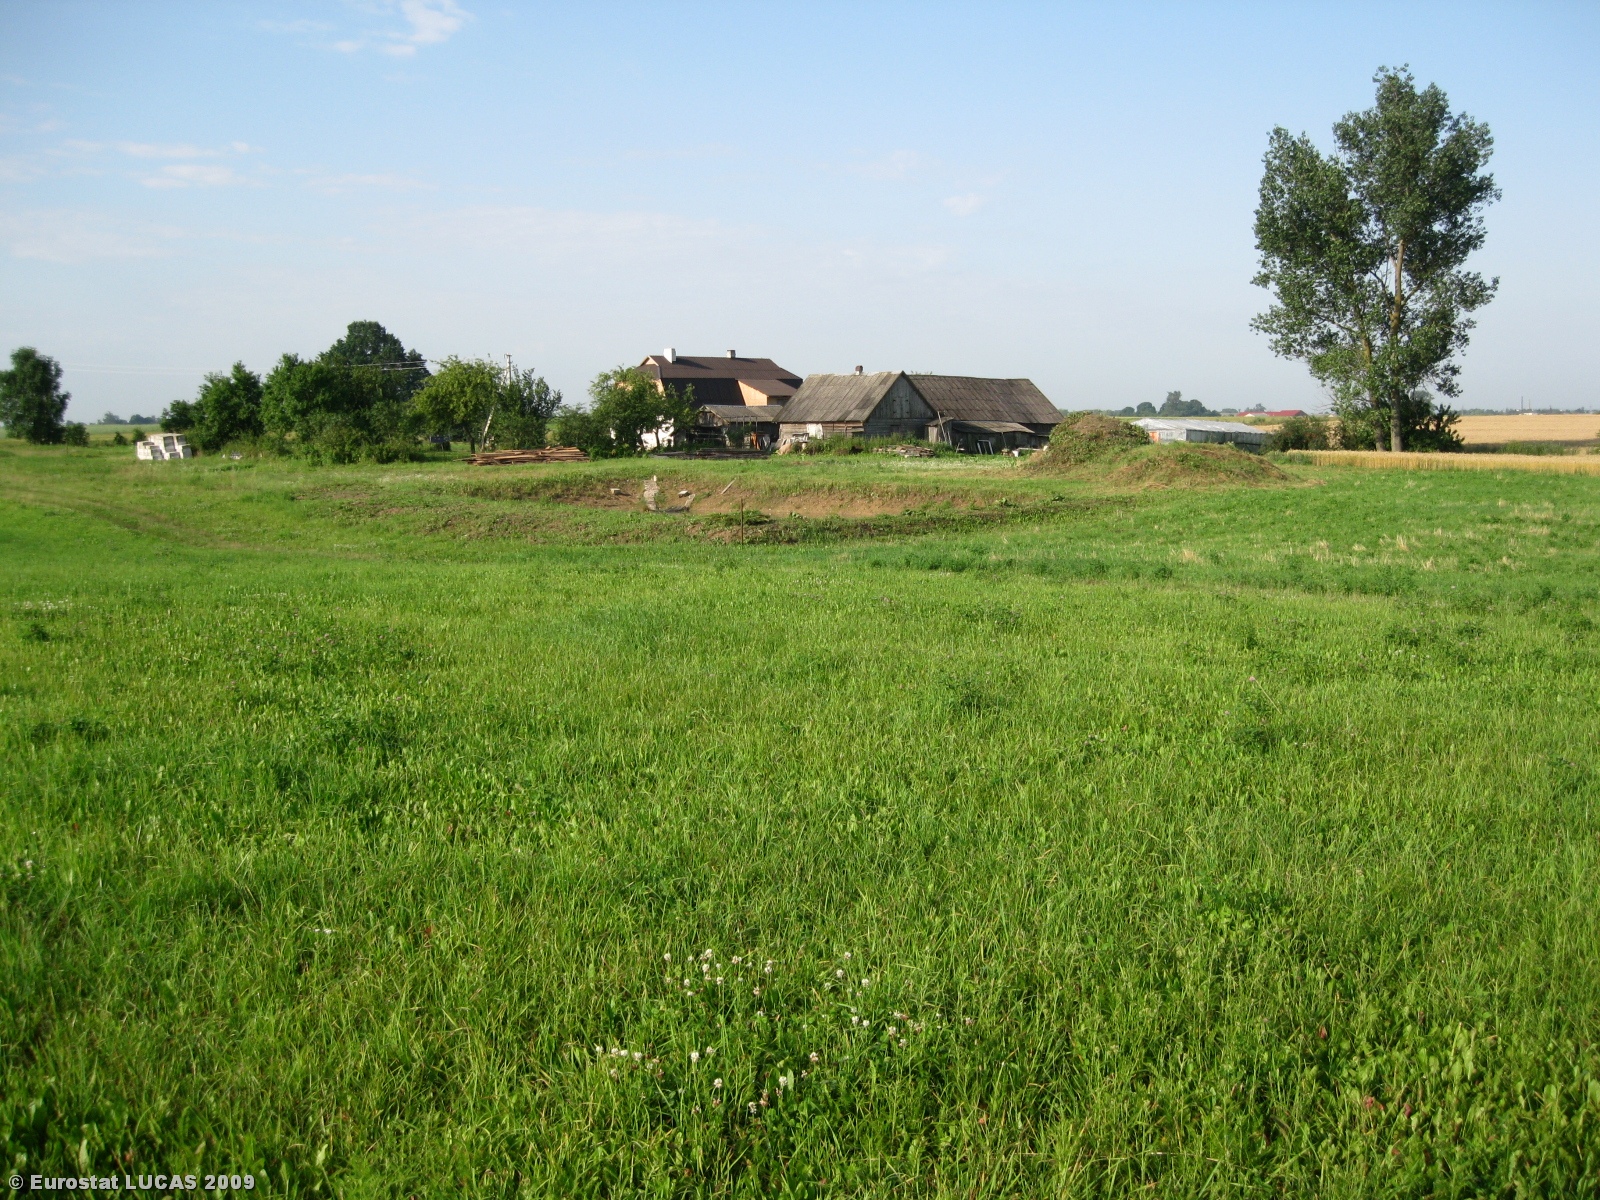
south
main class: Grassland
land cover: Grassland without tree/shrub cover
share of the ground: > 75 %
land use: Agriculture (excluding fallow land and kitchen gardens)
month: July
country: LT
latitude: 54.5651
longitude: 23.4275
